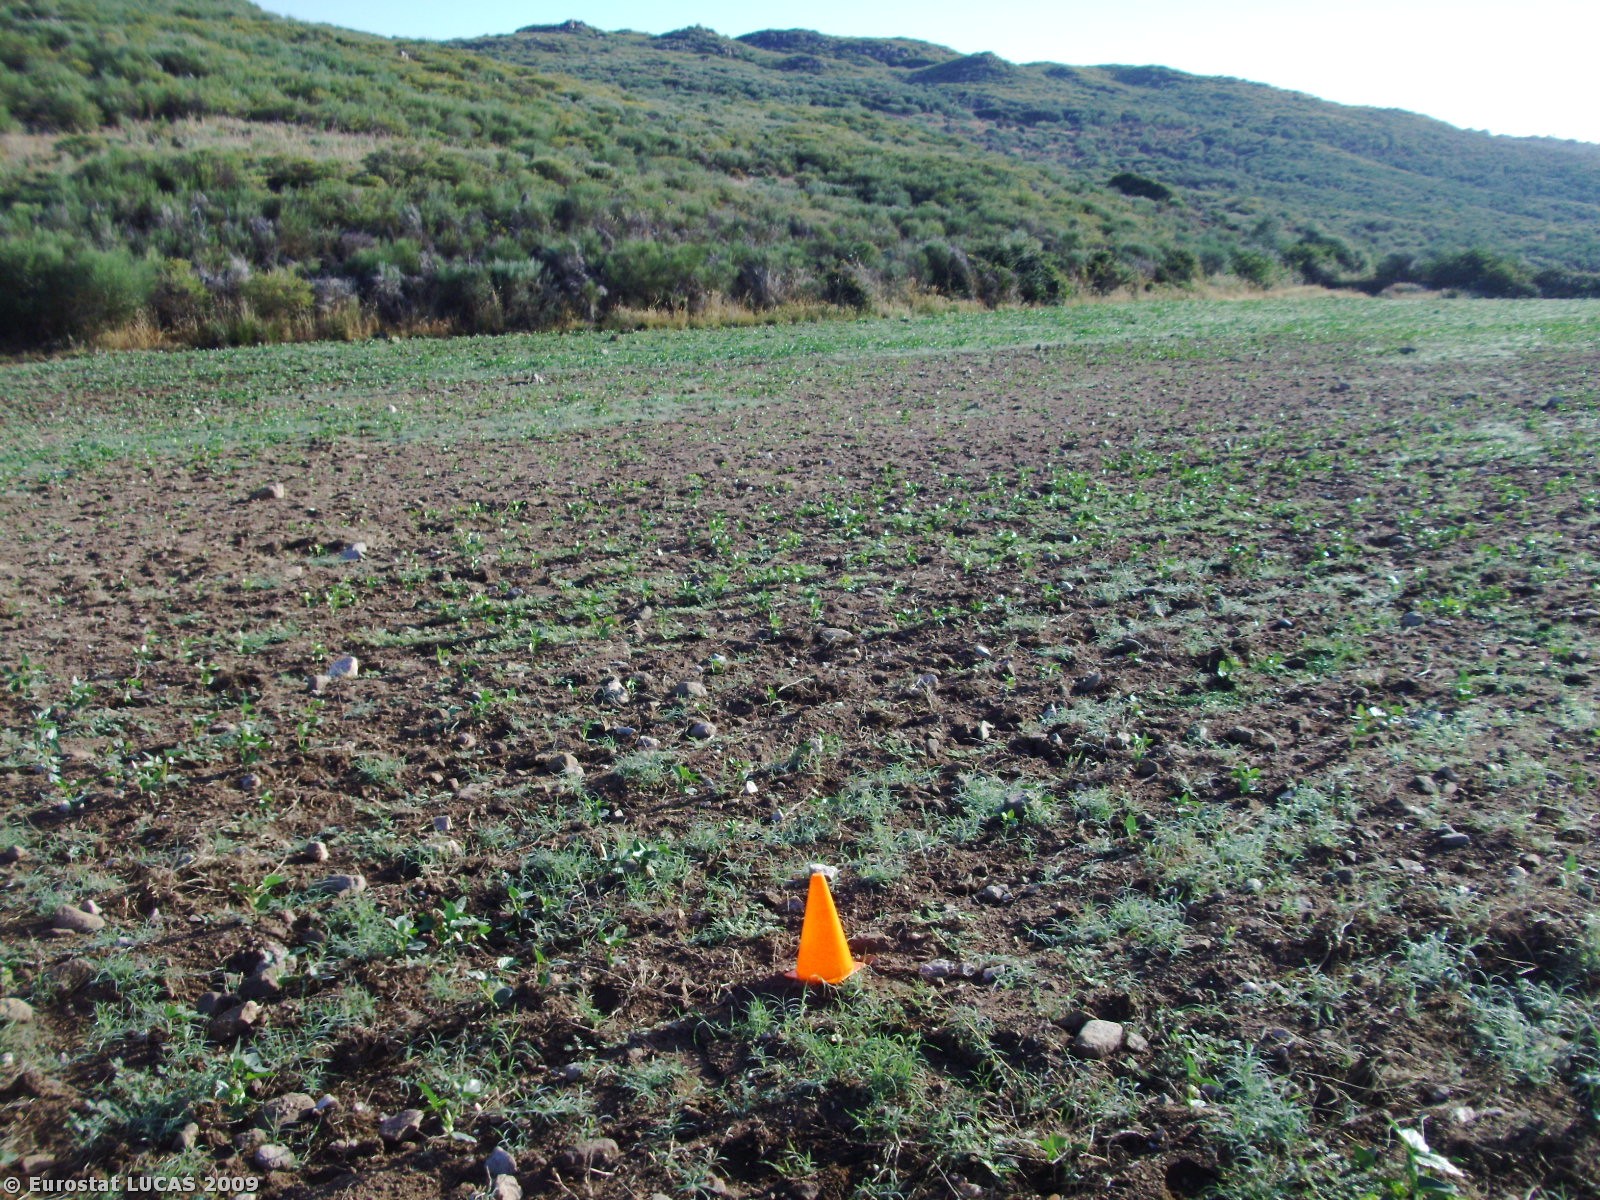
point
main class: Cropland
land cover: Other leguminous and mixtures for fodder
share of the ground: 25 - 50 %
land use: Agriculture (excluding fallow land and kitchen gardens)
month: June
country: PT
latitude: 39.9901
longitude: -7.3017
